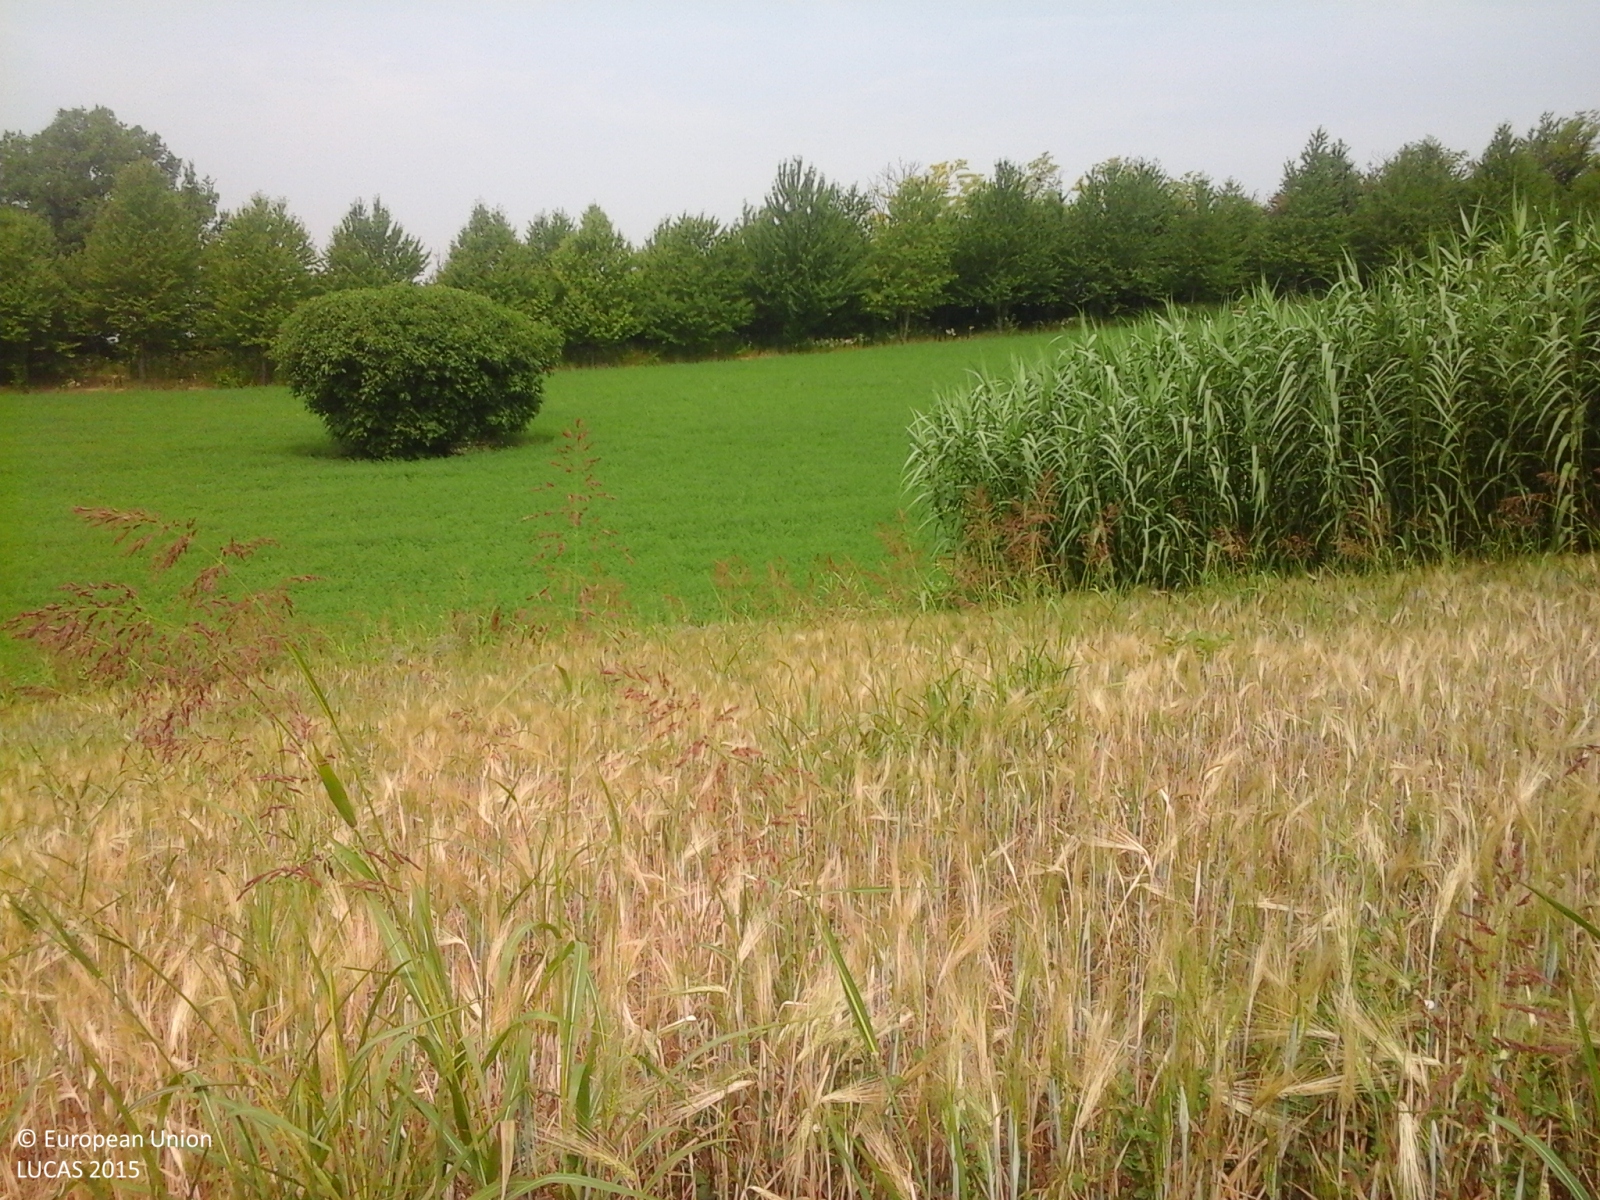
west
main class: Cropland
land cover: Barley
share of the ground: > 75 %
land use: Agriculture (excluding fallow land and kitchen gardens)
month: June
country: IT
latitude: 44.9723
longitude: 8.5952
